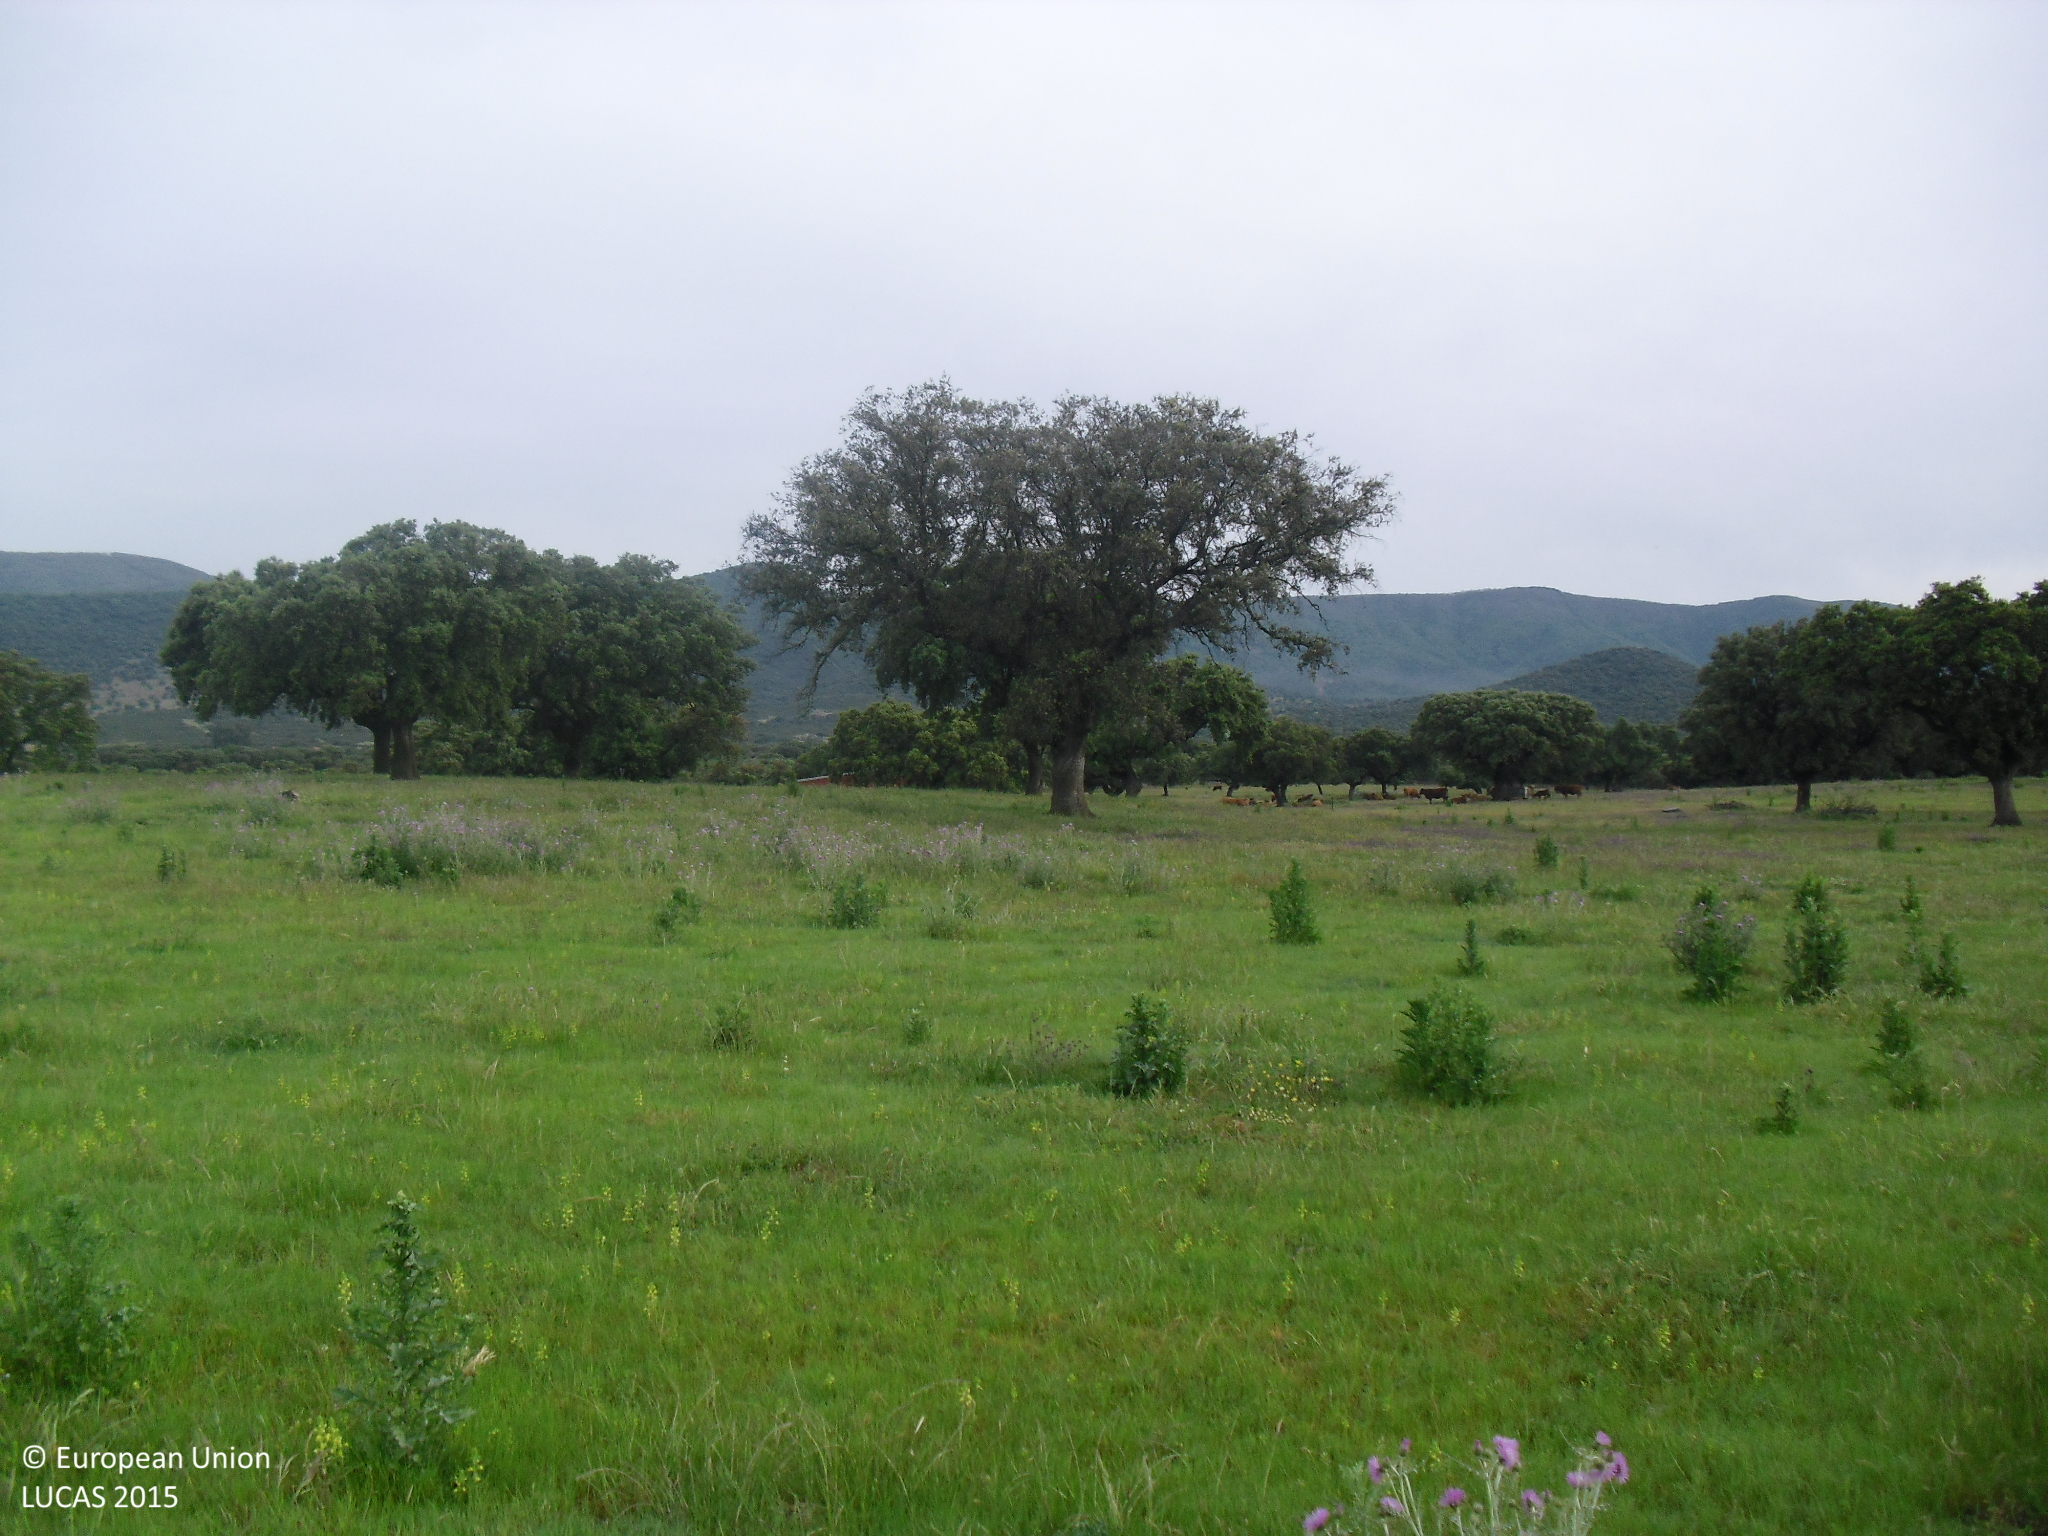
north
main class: Grassland
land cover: Grassland without tree/shrub cover
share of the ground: > 75 %
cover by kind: herbaceous plants 100 %
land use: Agriculture (excluding fallow land and kitchen gardens)
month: May
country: ES
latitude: 39.3336
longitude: -5.5377
